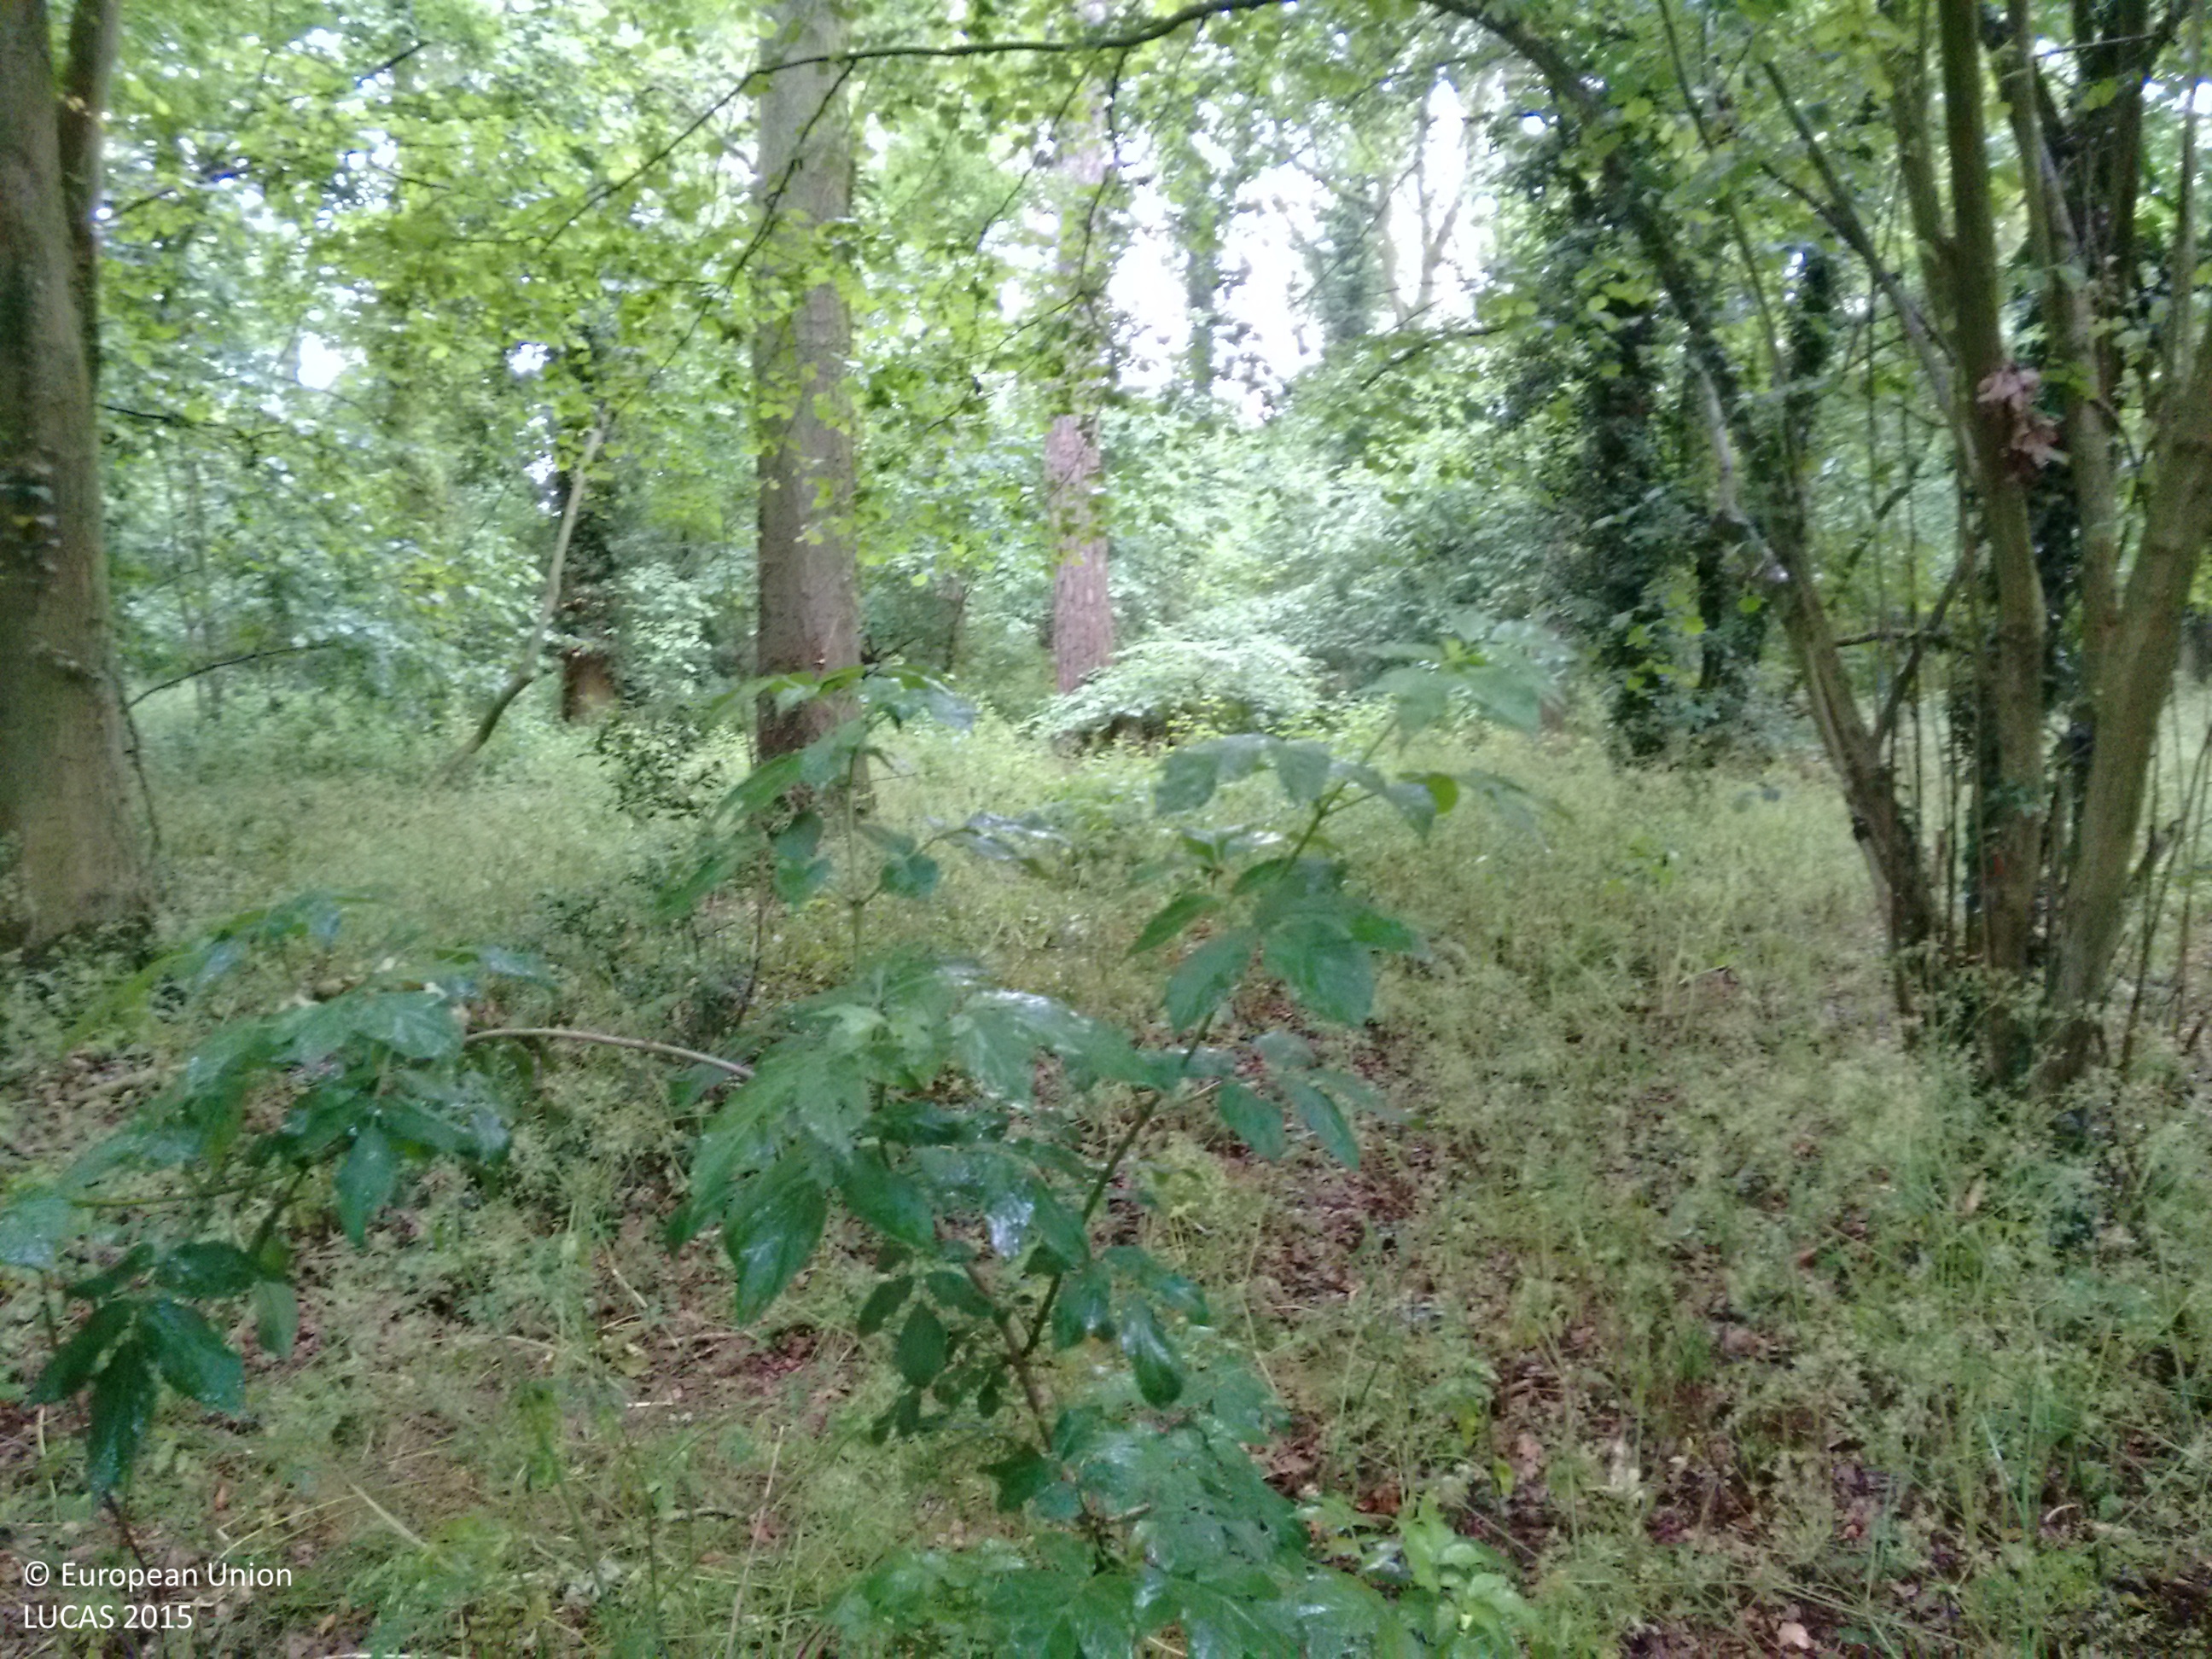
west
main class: Woodland
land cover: Broadleaved woodland
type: mesophytic deciduous forest
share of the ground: > 75 %
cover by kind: broadleaved forest trees 95 %, herbaceous plants 5 %
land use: Forestry
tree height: > 5 m
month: June
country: GB
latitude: 51.5105
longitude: -1.0973
